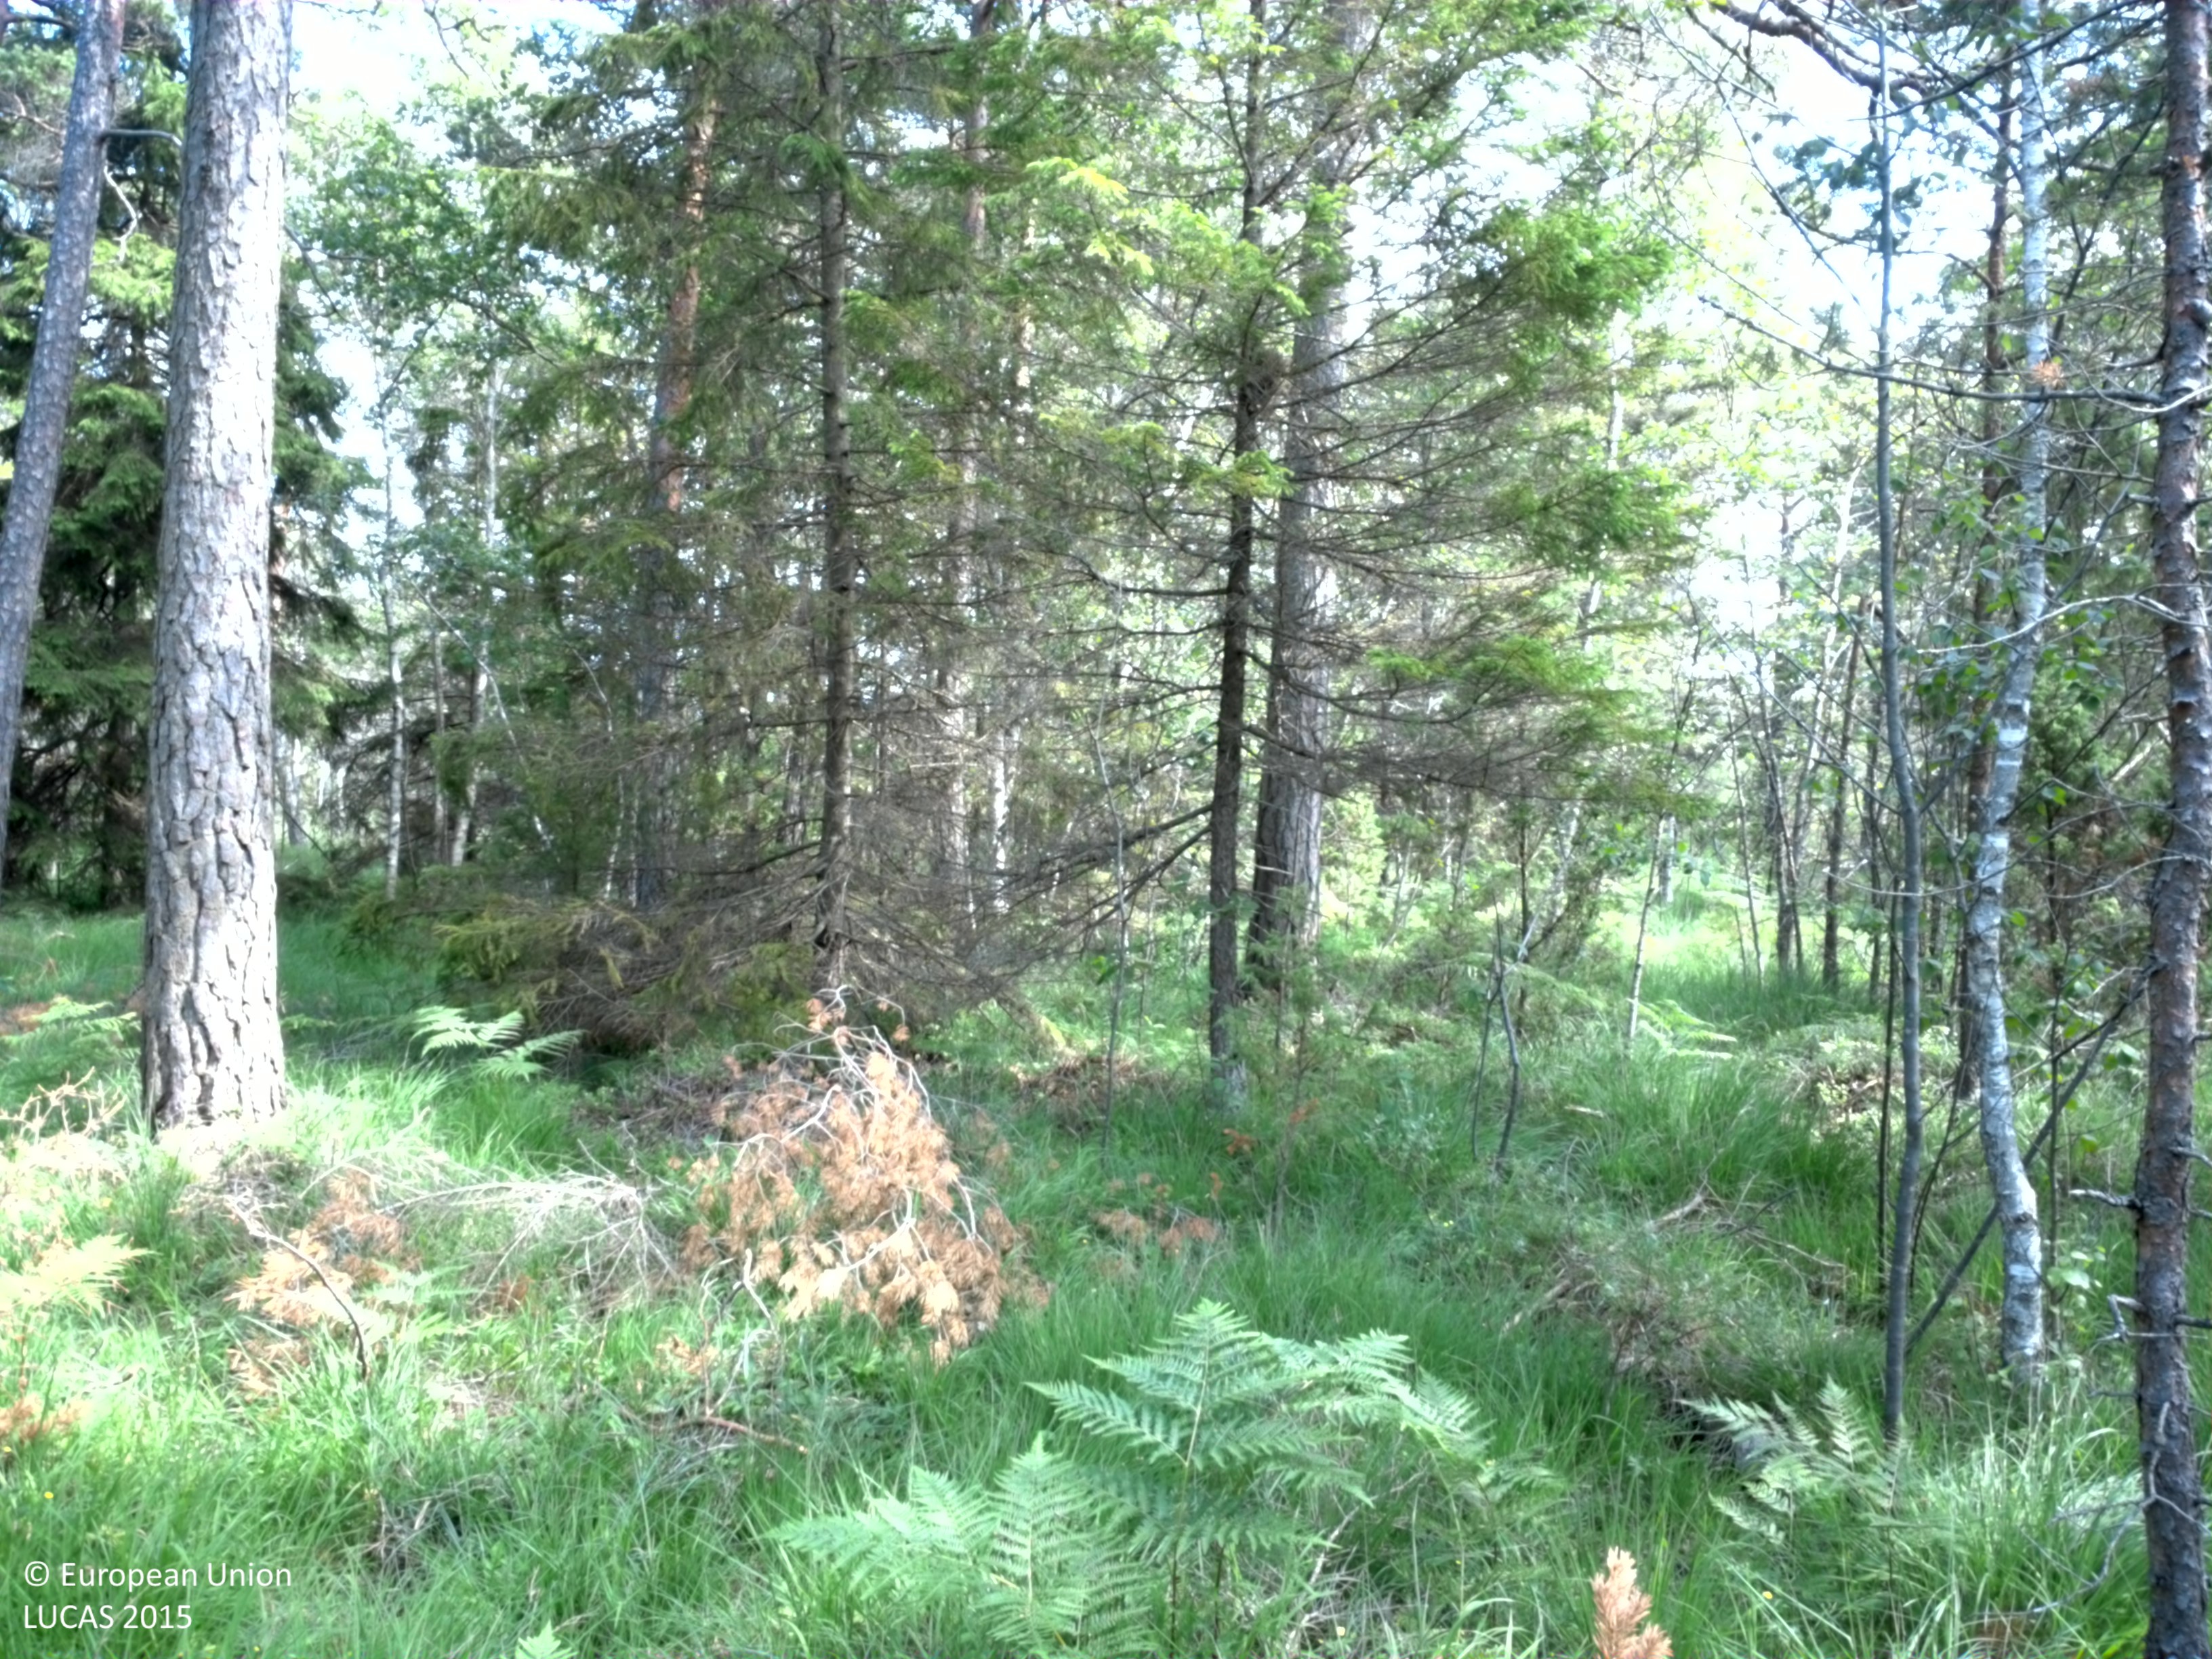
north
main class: Woodland
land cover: Pine dominated mixed woodland
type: hemiboreal forest and nemoral coniferous forest and mixed broadleaved-coniferous forest
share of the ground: 50 - 75 %
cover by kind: herbaceous plants 40 %, coniferous forest trees 35 %, broadleaved forest trees 20 %, shrubs 5 %
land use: Forestry
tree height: > 5 m
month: July
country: SE
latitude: 57.3932
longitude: 18.7125
